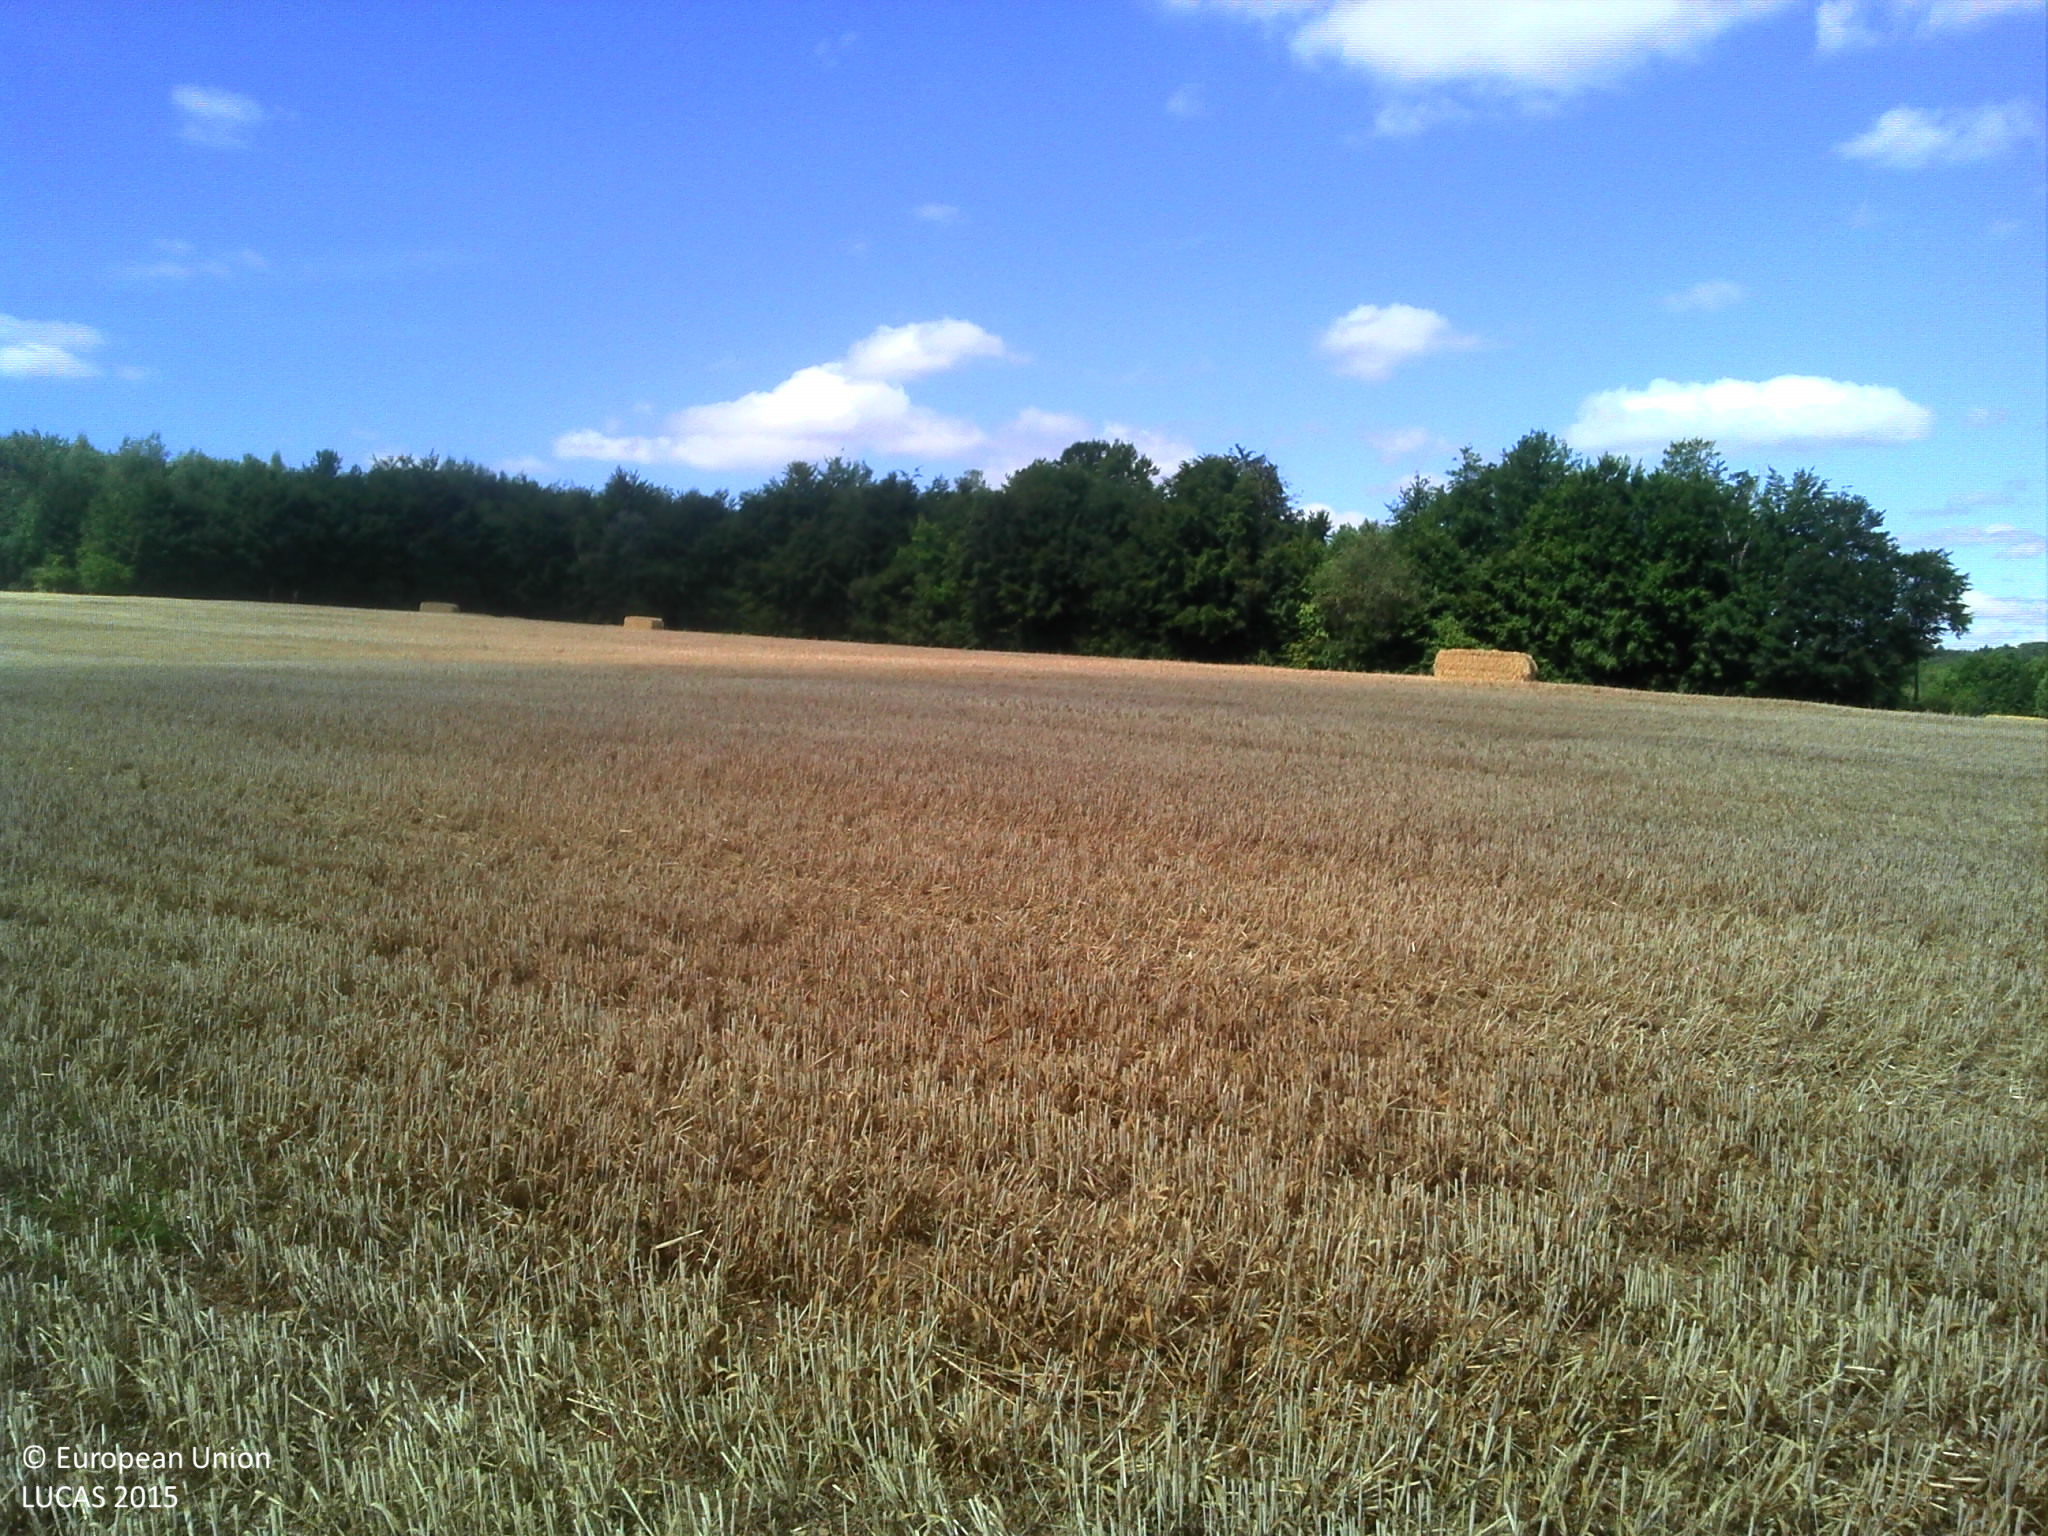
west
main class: Cropland
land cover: Barley
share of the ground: 10 - 25 %
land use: Agriculture (excluding fallow land and kitchen gardens)
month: July
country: FR
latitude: 47.9194
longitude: 5.1688
